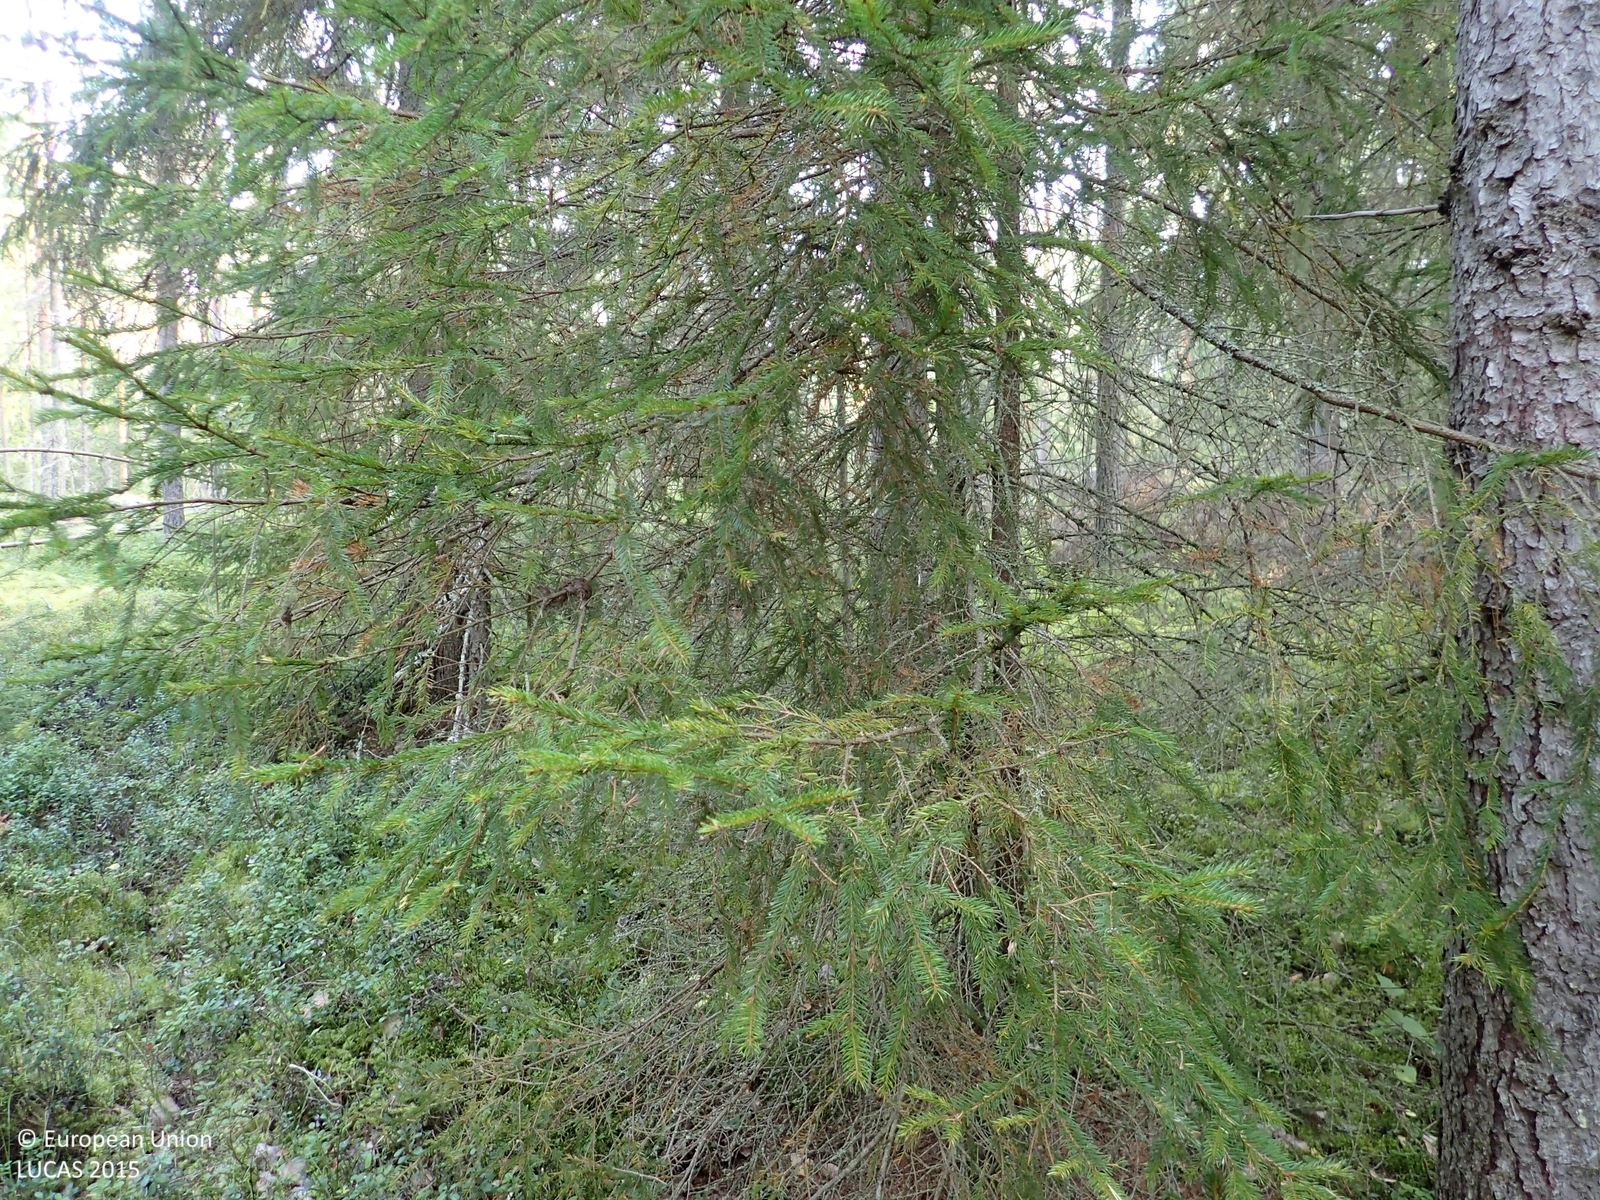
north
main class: Woodland
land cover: Spruce dominated coniferous woodland
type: boreal forest
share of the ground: > 75 %
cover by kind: coniferous forest trees 75 %, shrubs 15 %, broadleaved forest trees 5 %, lichens and mosses 5 %
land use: Forestry
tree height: > 5 m
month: September
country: FI
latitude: 63.0746
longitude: 25.6884
